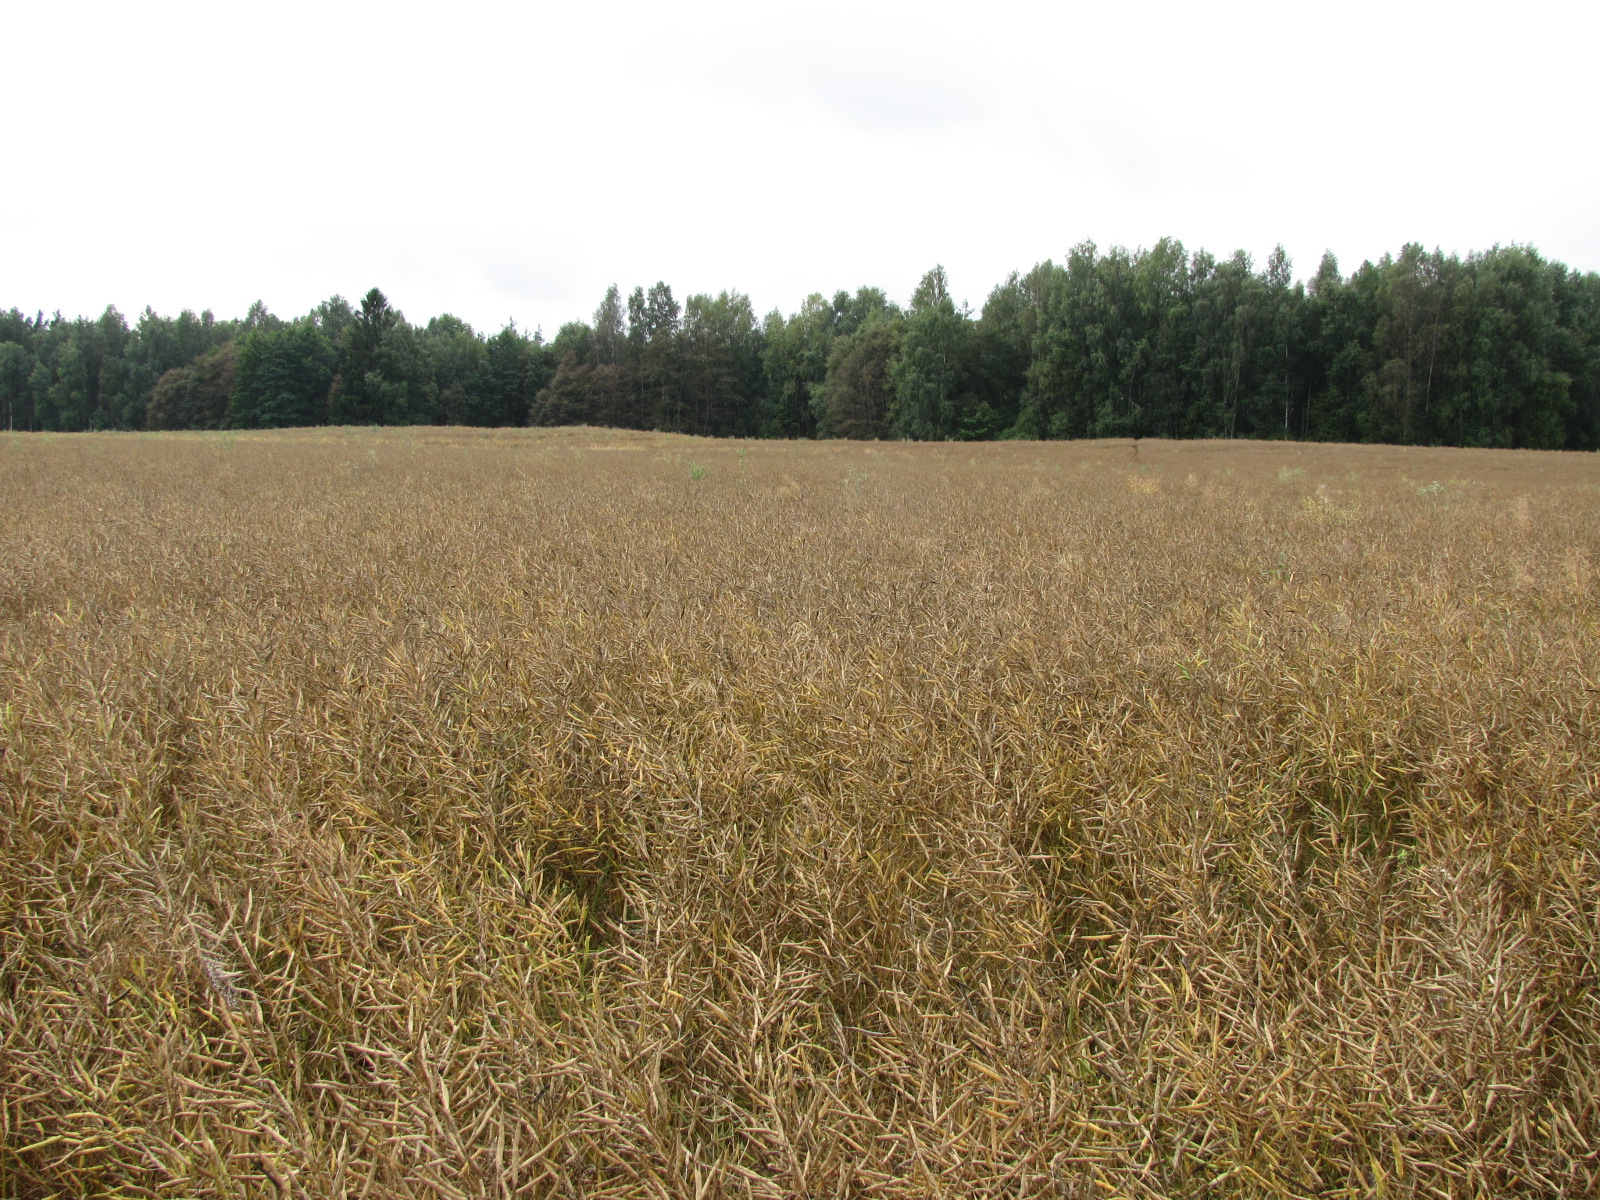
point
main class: Cropland
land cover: Rape and turnip rape
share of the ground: > 75 %
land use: Agriculture (excluding fallow land and kitchen gardens)
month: September
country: LV
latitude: 56.6388
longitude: 25.2942
